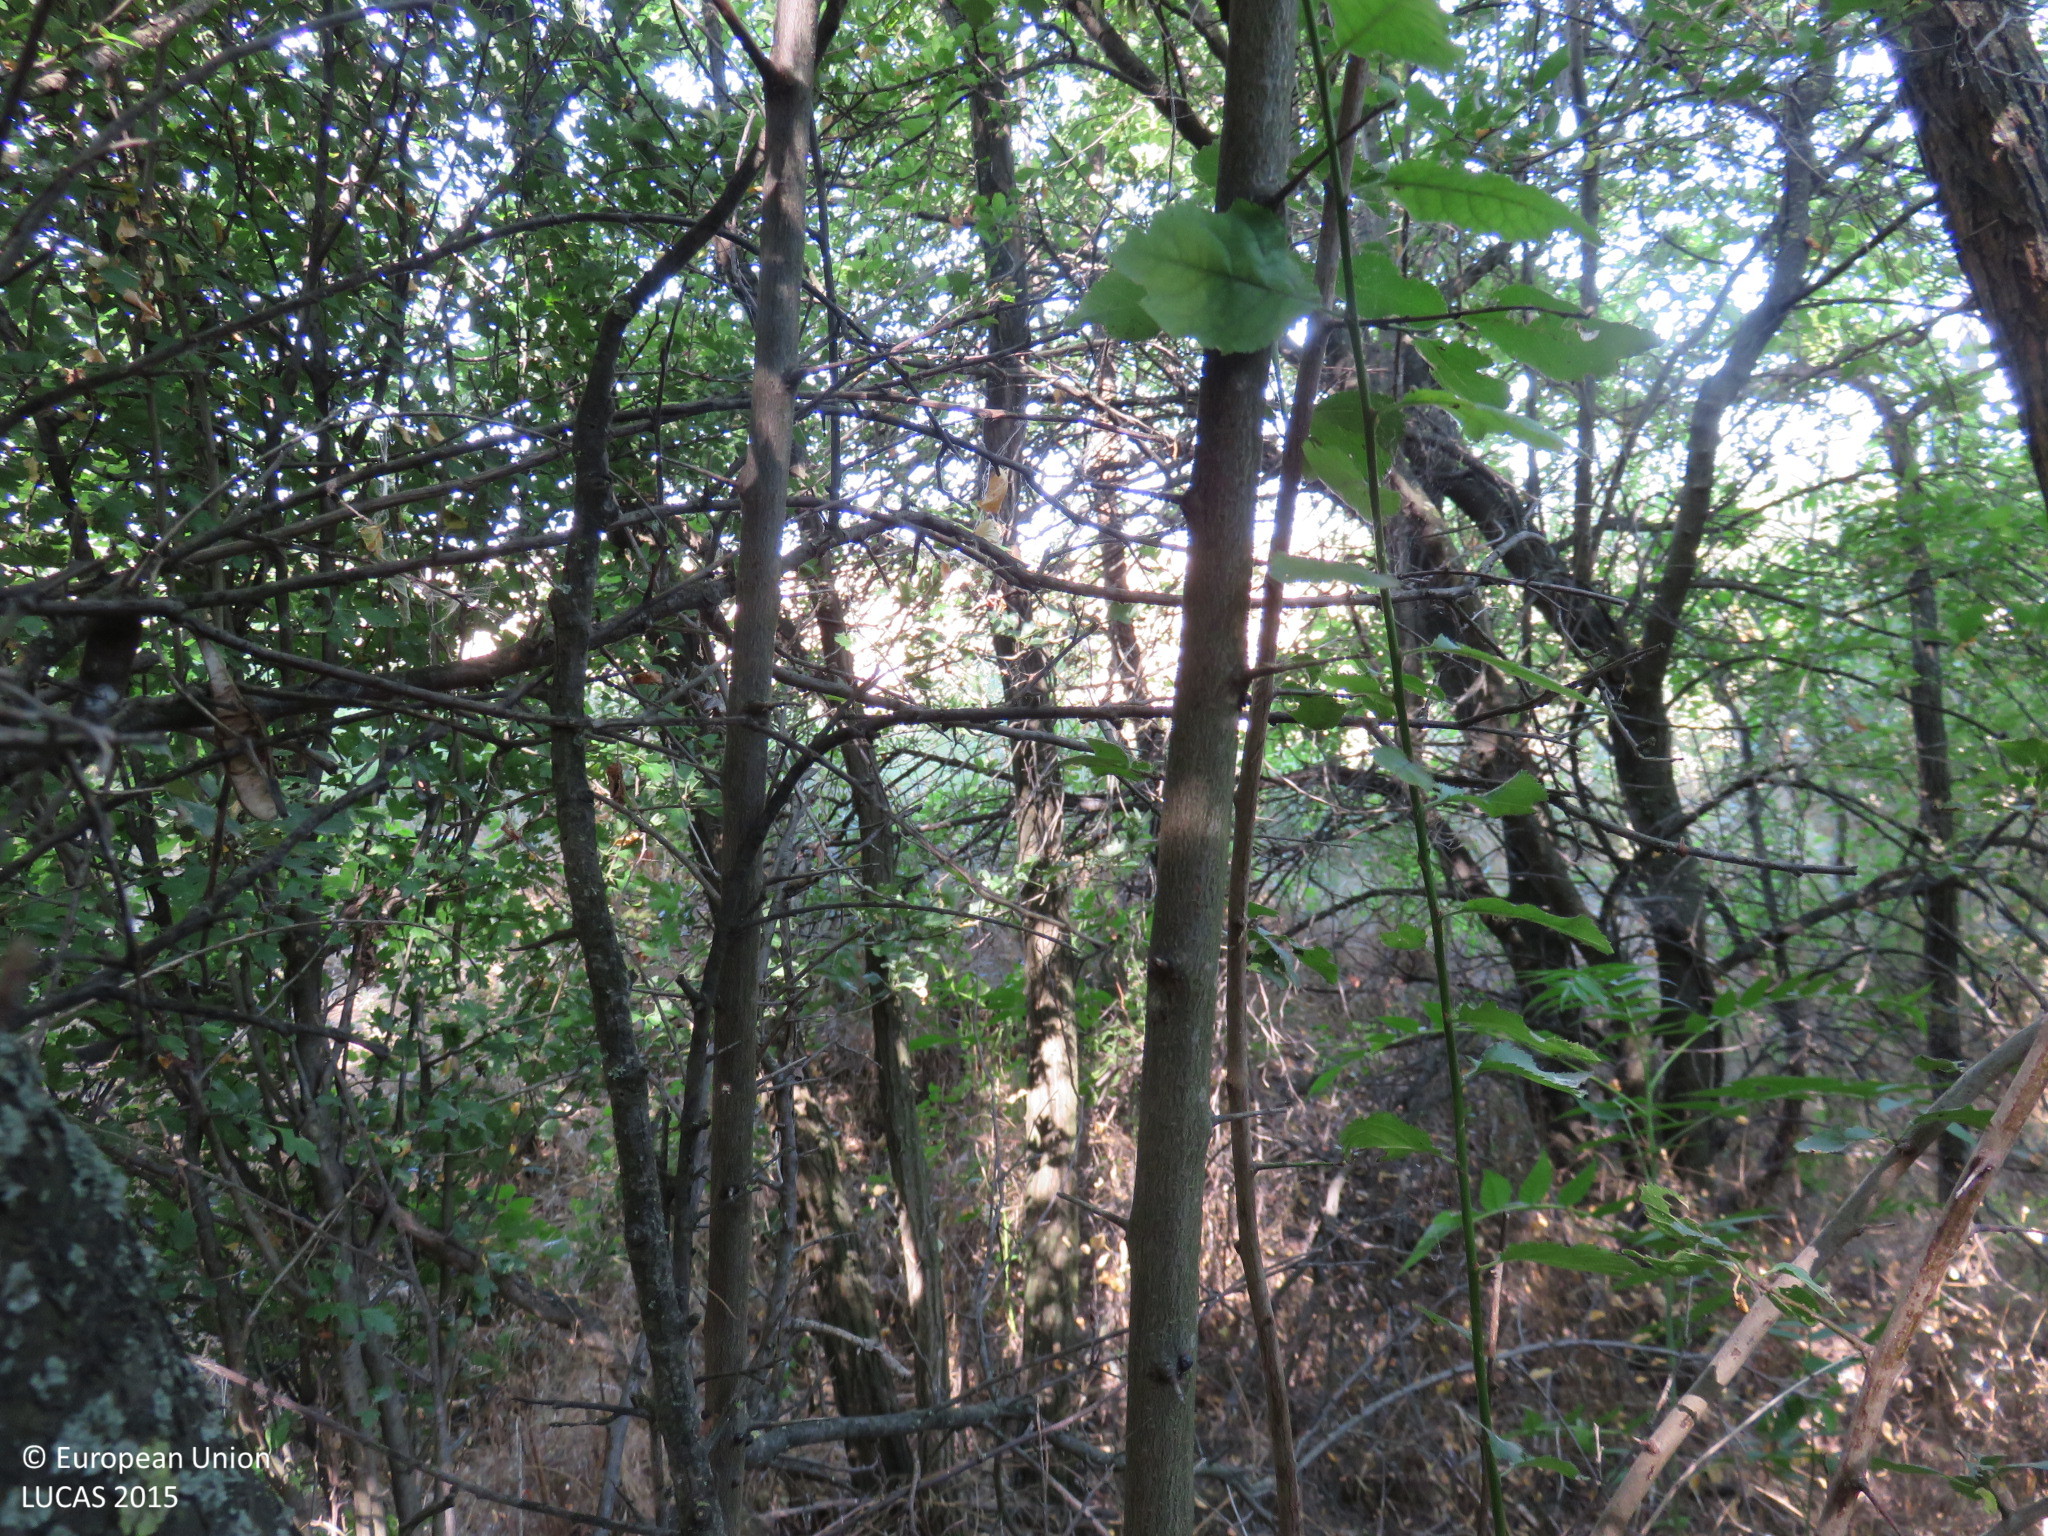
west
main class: Woodland
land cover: Broadleaved woodland
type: mesophytic deciduous forest
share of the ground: > 75 %
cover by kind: broadleaved forest trees 95 %, shrubs 5 %
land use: Forestry
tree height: > 5 m
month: July
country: BG
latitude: 43.5228
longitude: 25.1562
